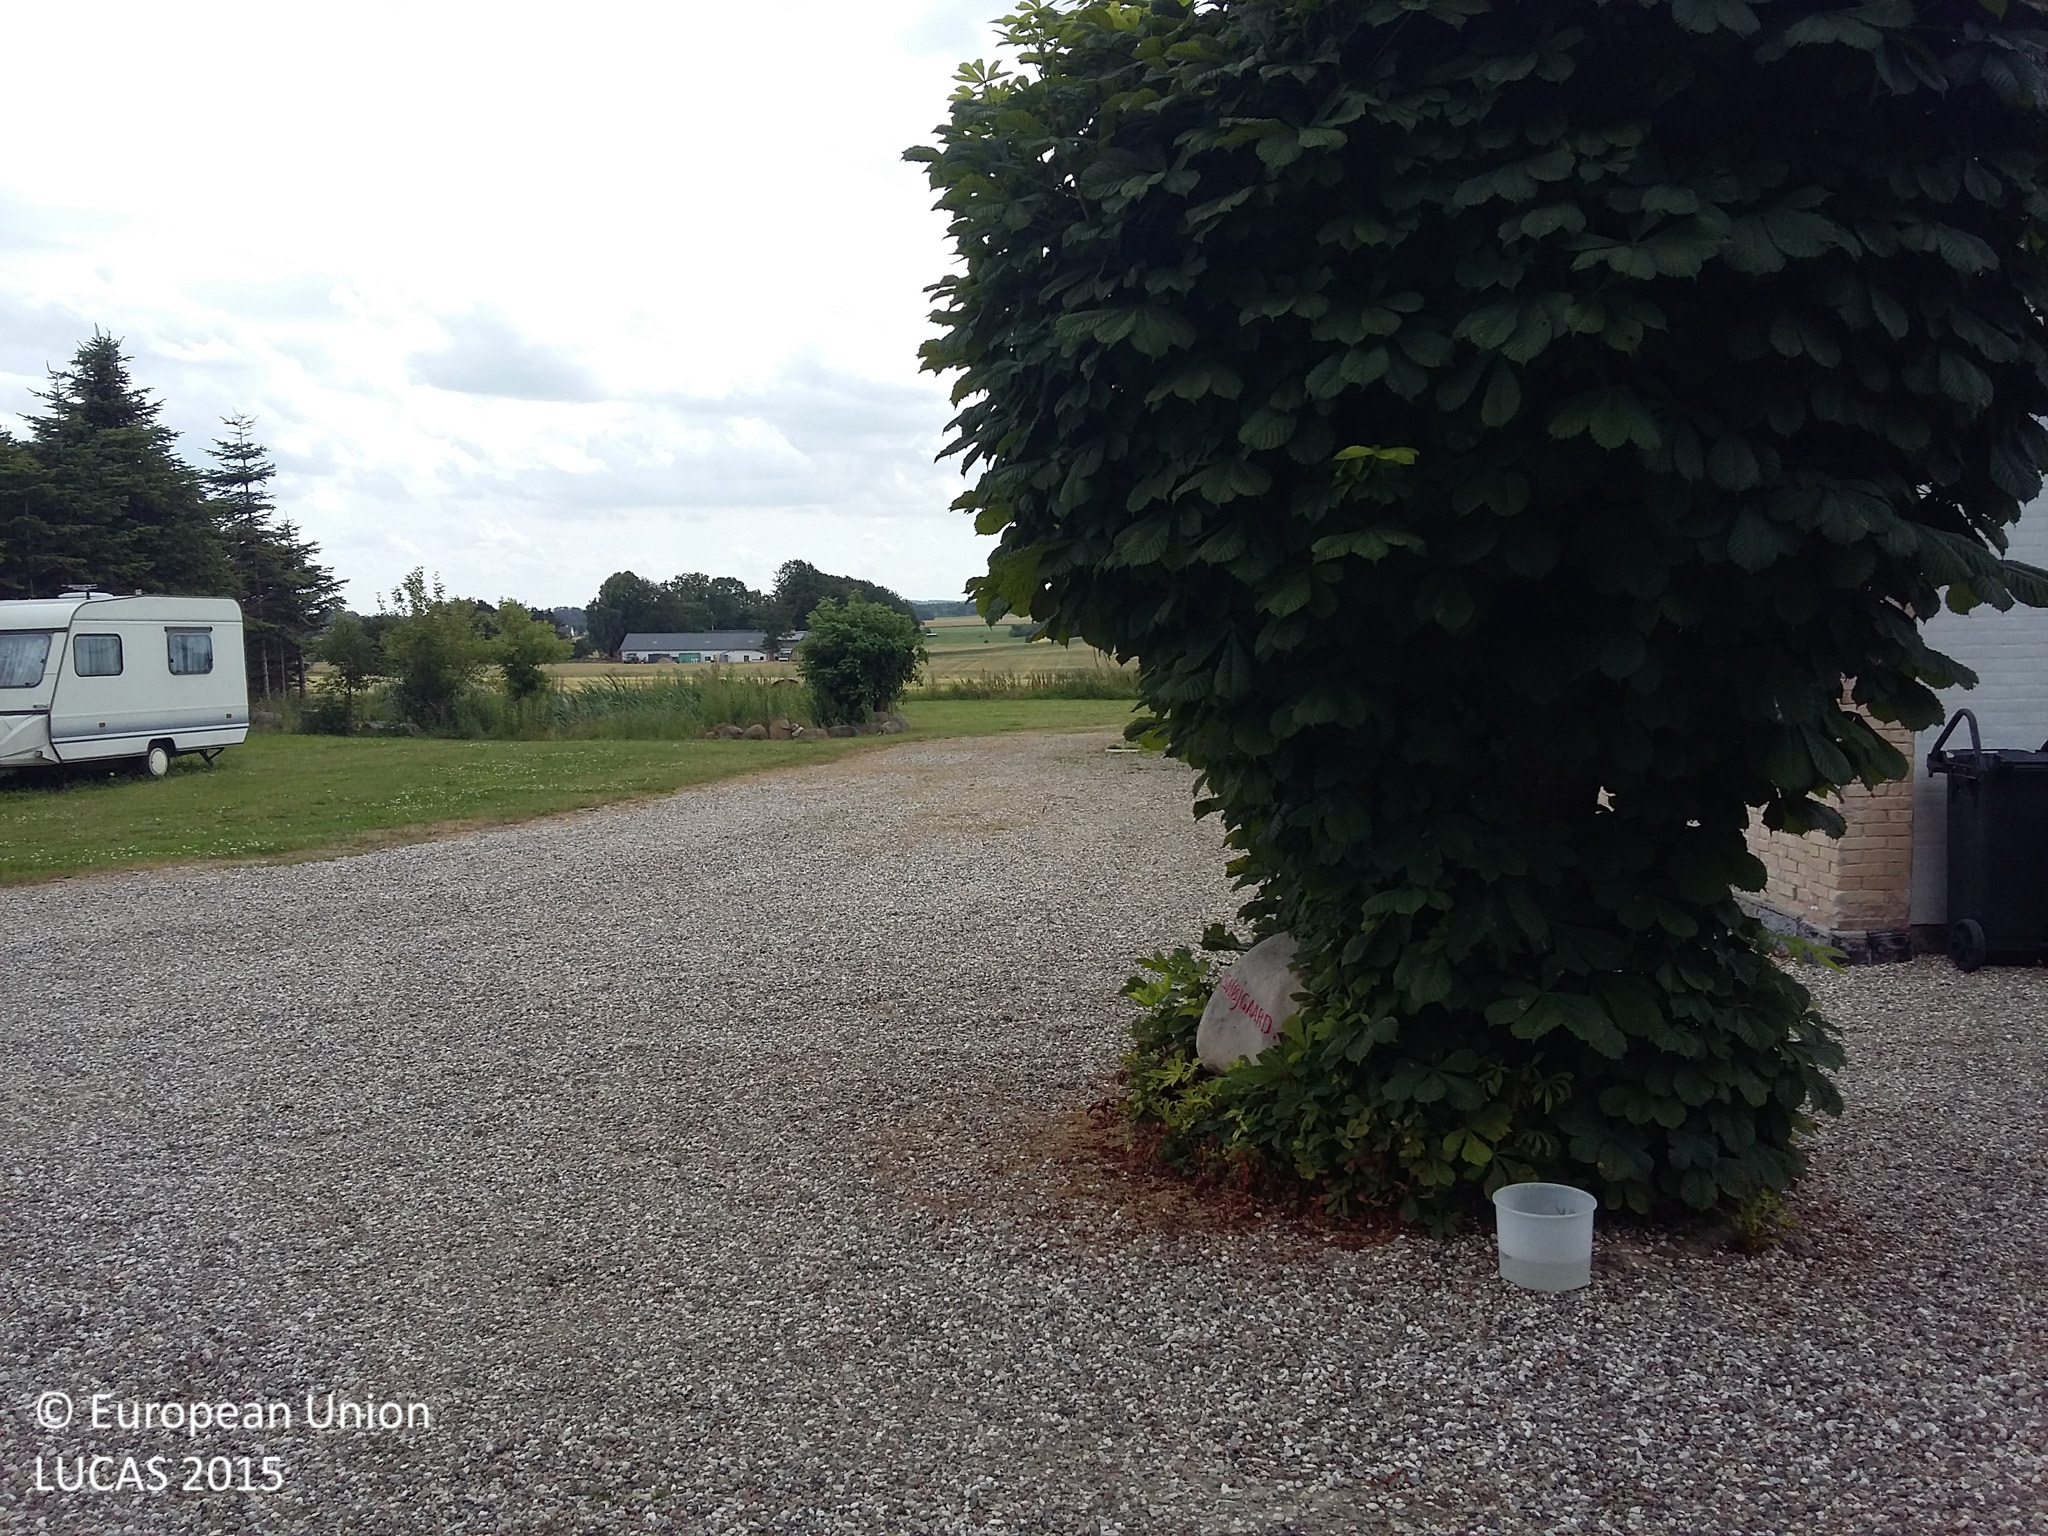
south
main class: Woodland
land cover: Broadleaved woodland
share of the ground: > 75 %
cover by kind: broadleaved forest trees 80 %, herbaceous plants 20 %
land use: Residential
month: July
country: DK
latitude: 55.7058
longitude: 11.9239
